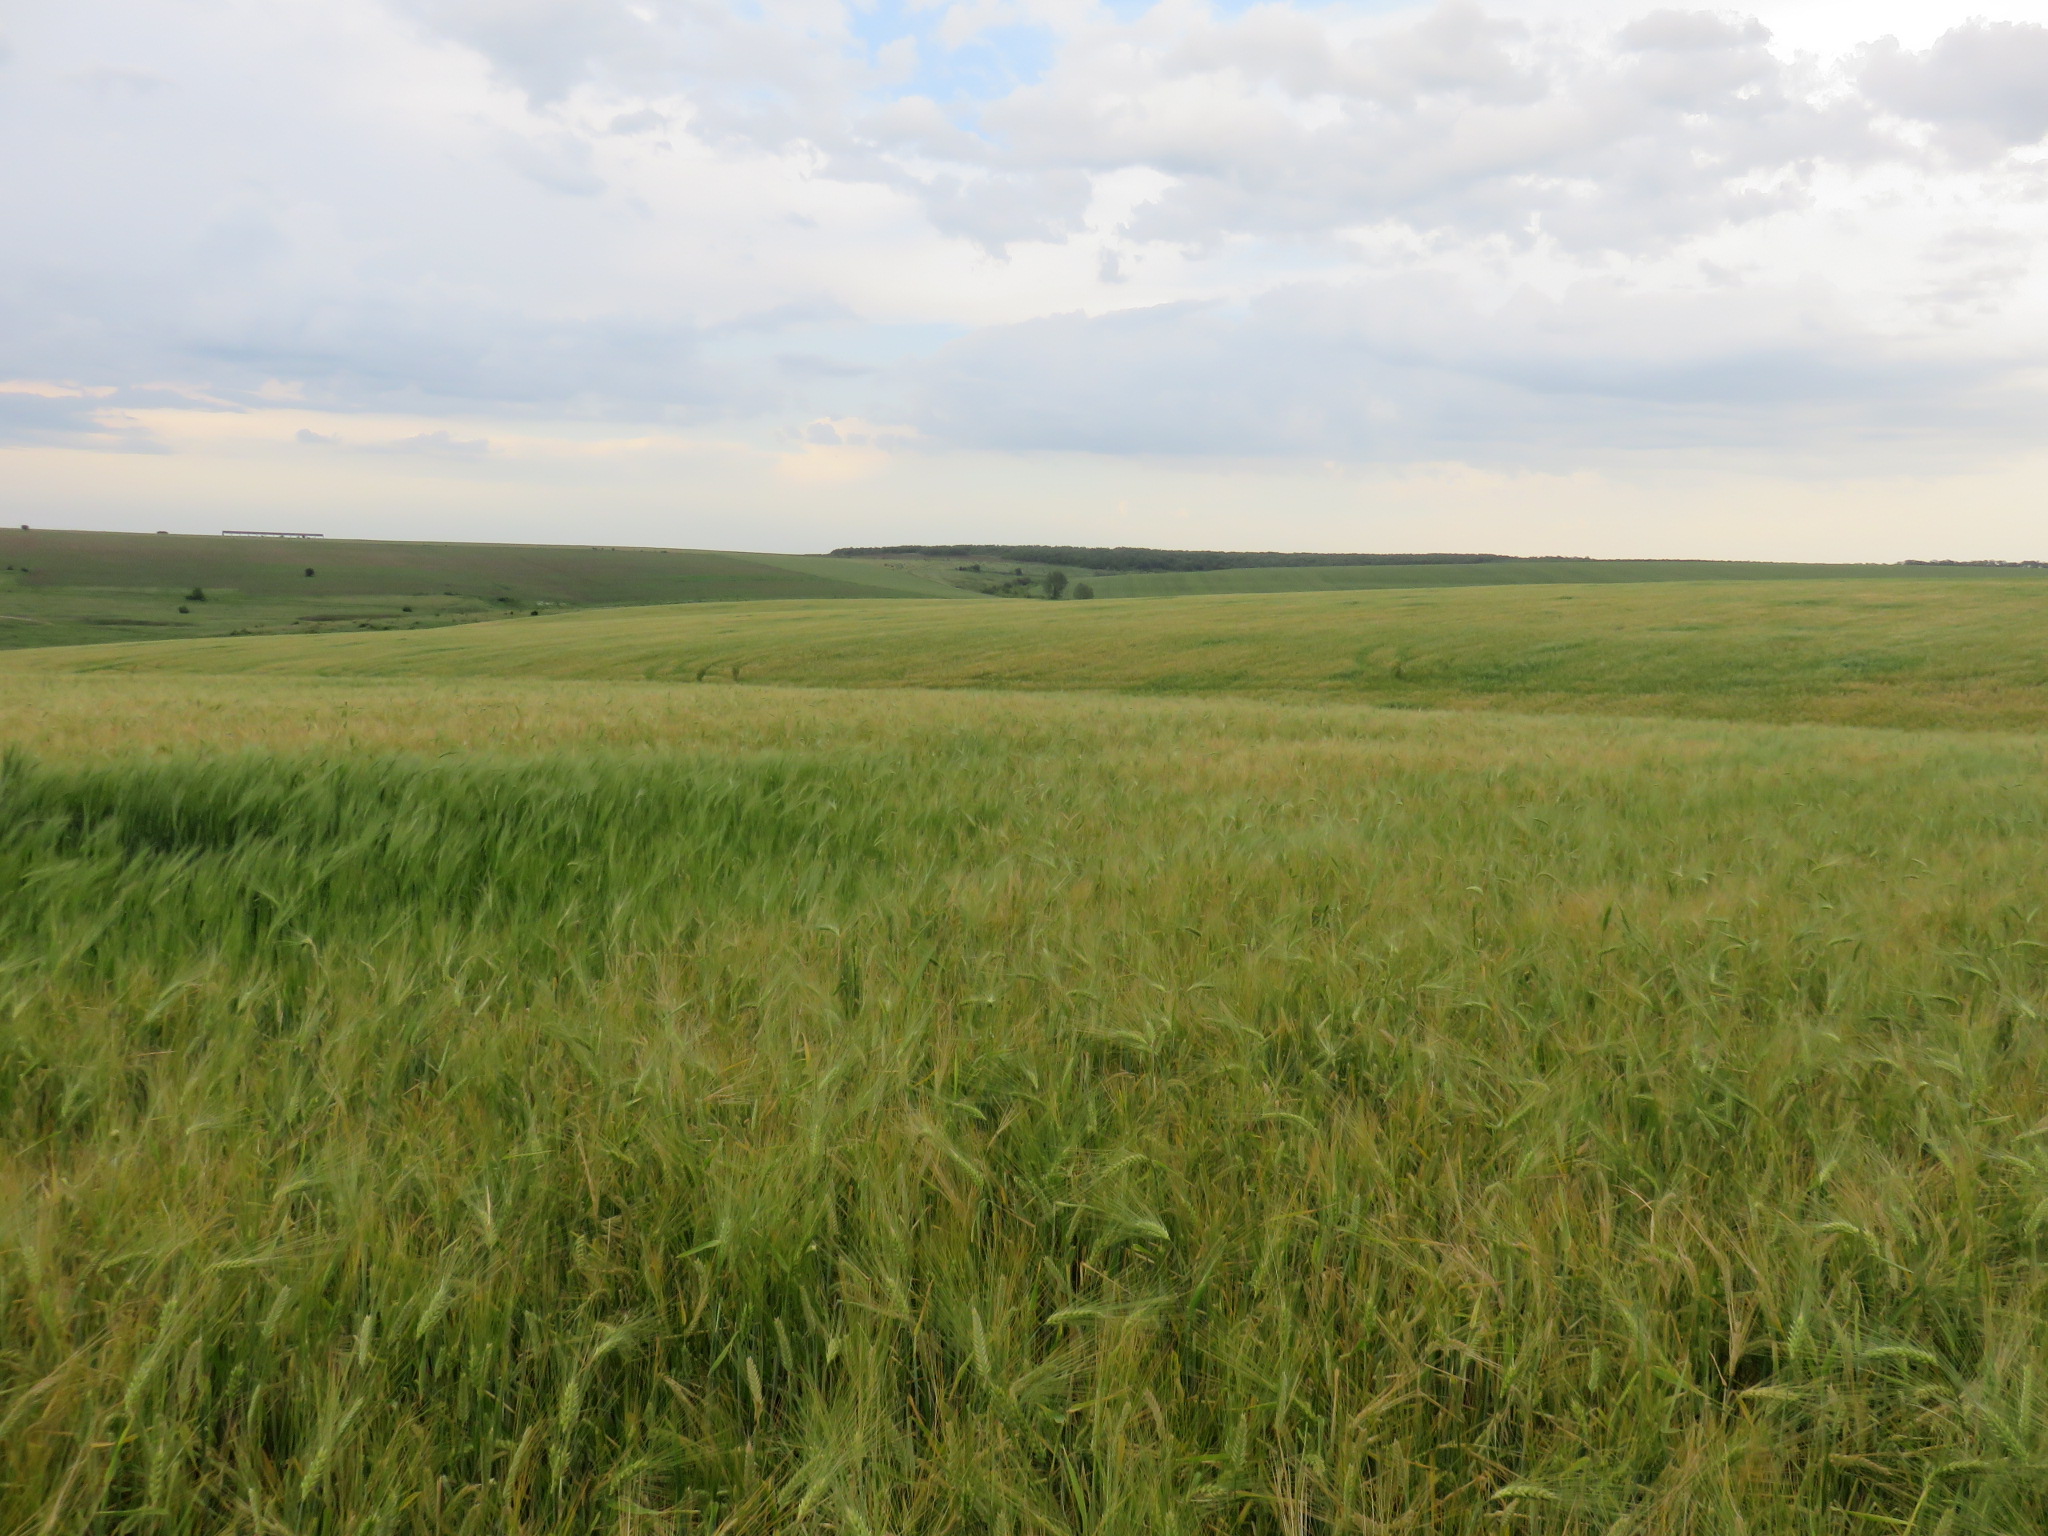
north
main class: Cropland
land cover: Barley
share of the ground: > 75 %
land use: Agriculture (excluding fallow land and kitchen gardens)
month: May
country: BG
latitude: 43.3080
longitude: 24.4963
